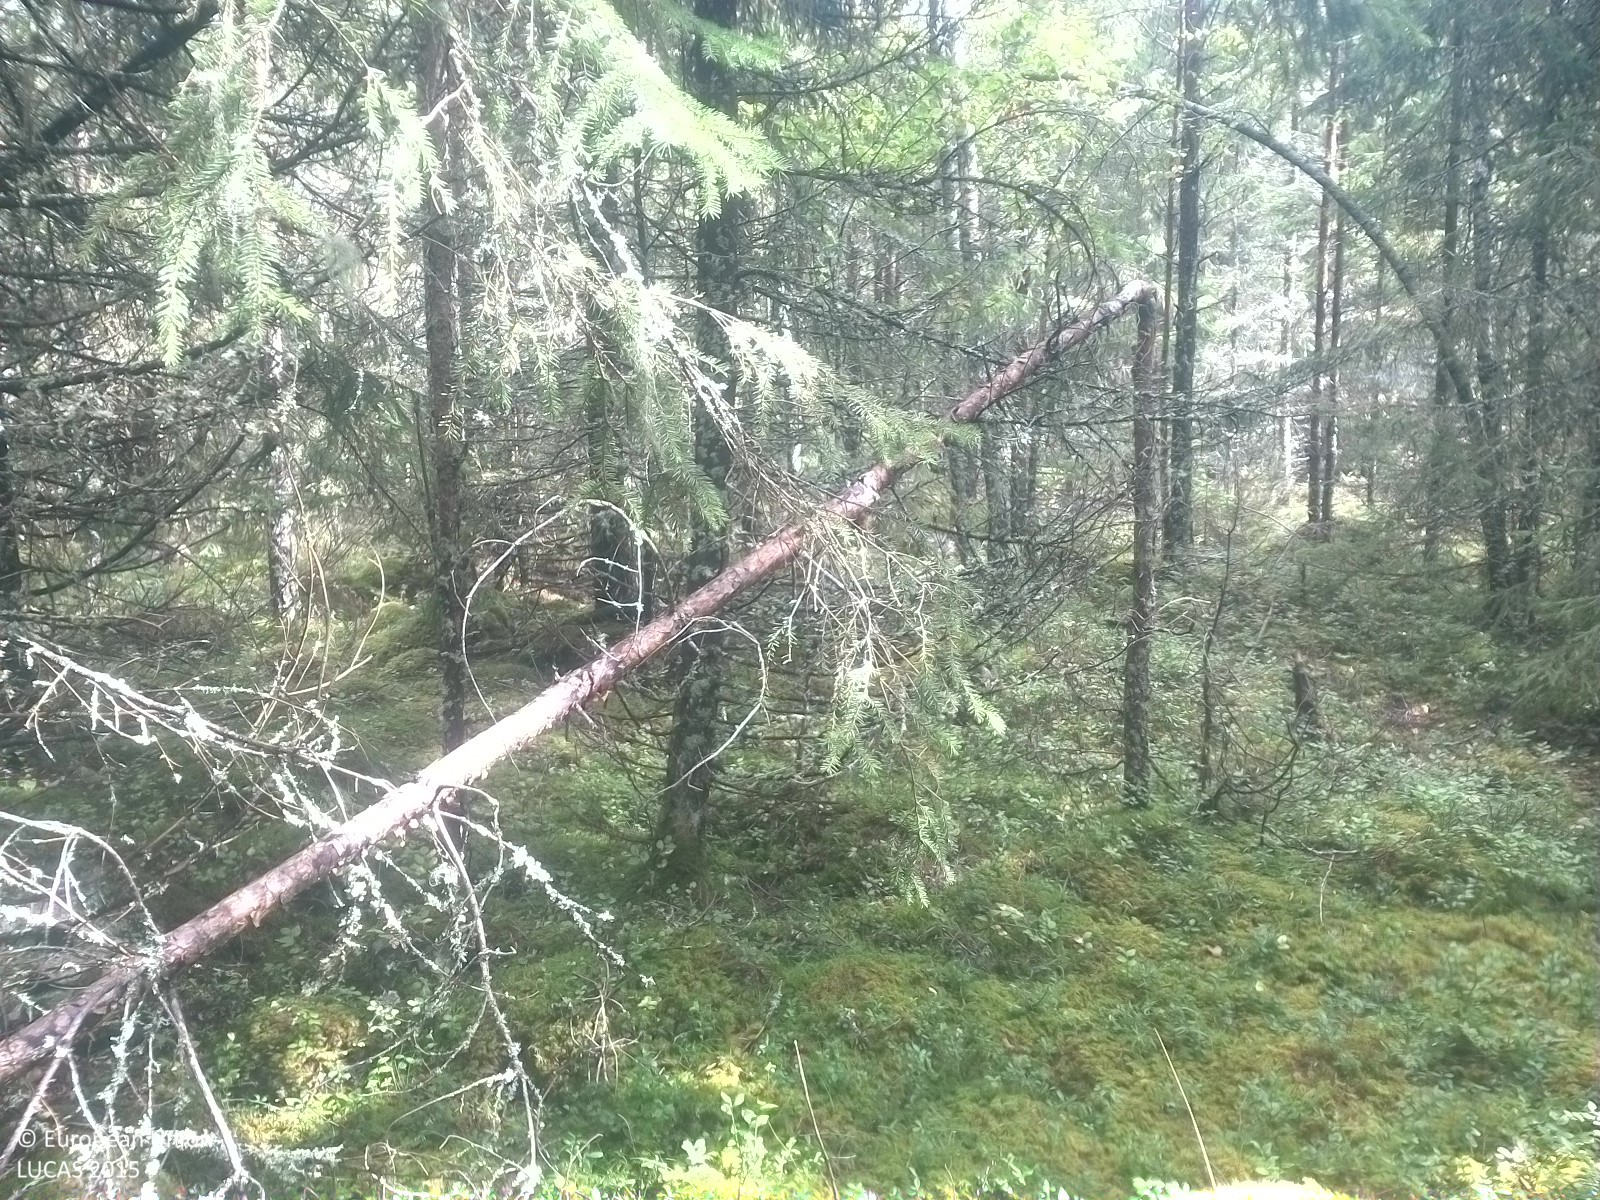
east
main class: Woodland
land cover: Spruce dominated coniferous woodland
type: boreal forest
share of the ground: 25 - 50 %
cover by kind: coniferous forest trees 40 %, herbaceous plants 25 %, lichens and mosses 25 %, broadleaved forest trees 5 %, shrubs 5 %
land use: Forestry
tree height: > 5 m
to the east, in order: Spruce dominated coniferous woodland; Other coniferous woodland; Pine dominated coniferous woodland; Spruce dominated coniferous woodland; Spruce dominated mixed woodland; Pine dominated coniferous woodland; Pine dominated mixed woodland
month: September
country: SE
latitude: 59.3985
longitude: 15.6801
